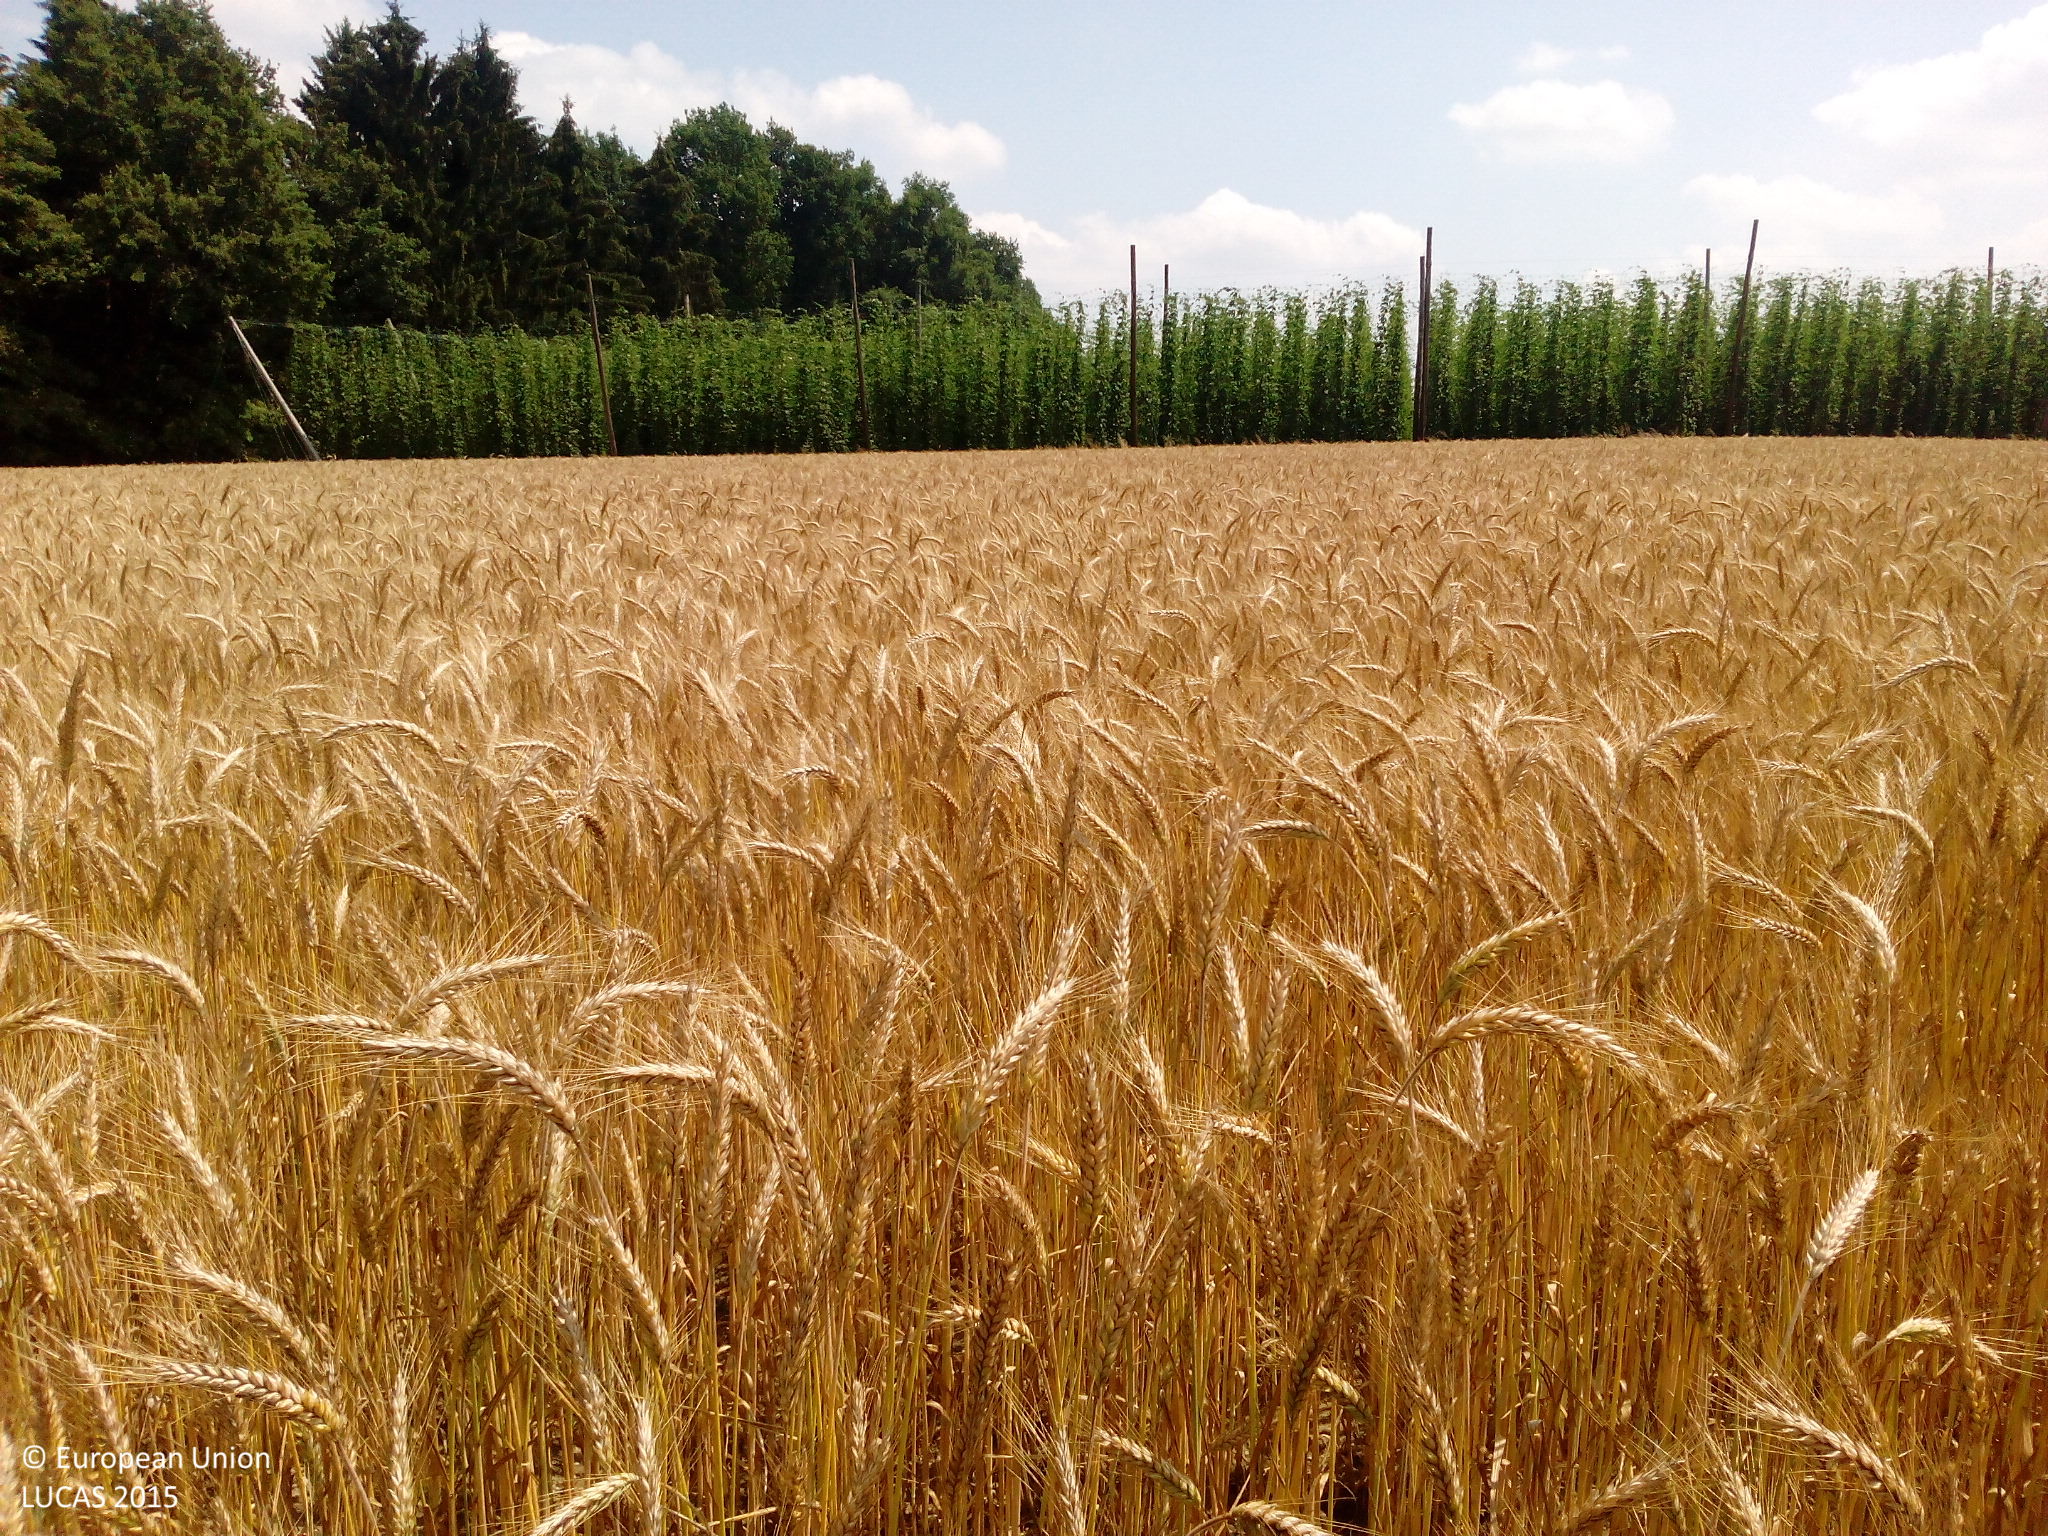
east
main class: Cropland
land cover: Rye
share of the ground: > 75 %
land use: Agriculture (excluding fallow land and kitchen gardens)
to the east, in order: Rye; Other non-permanent industrial crops; Grass margins; Tracks; Grass margins; Broadleaved woodland; Grassland without tree/shrub cover
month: July
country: DE
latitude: 48.8008
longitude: 11.9190
